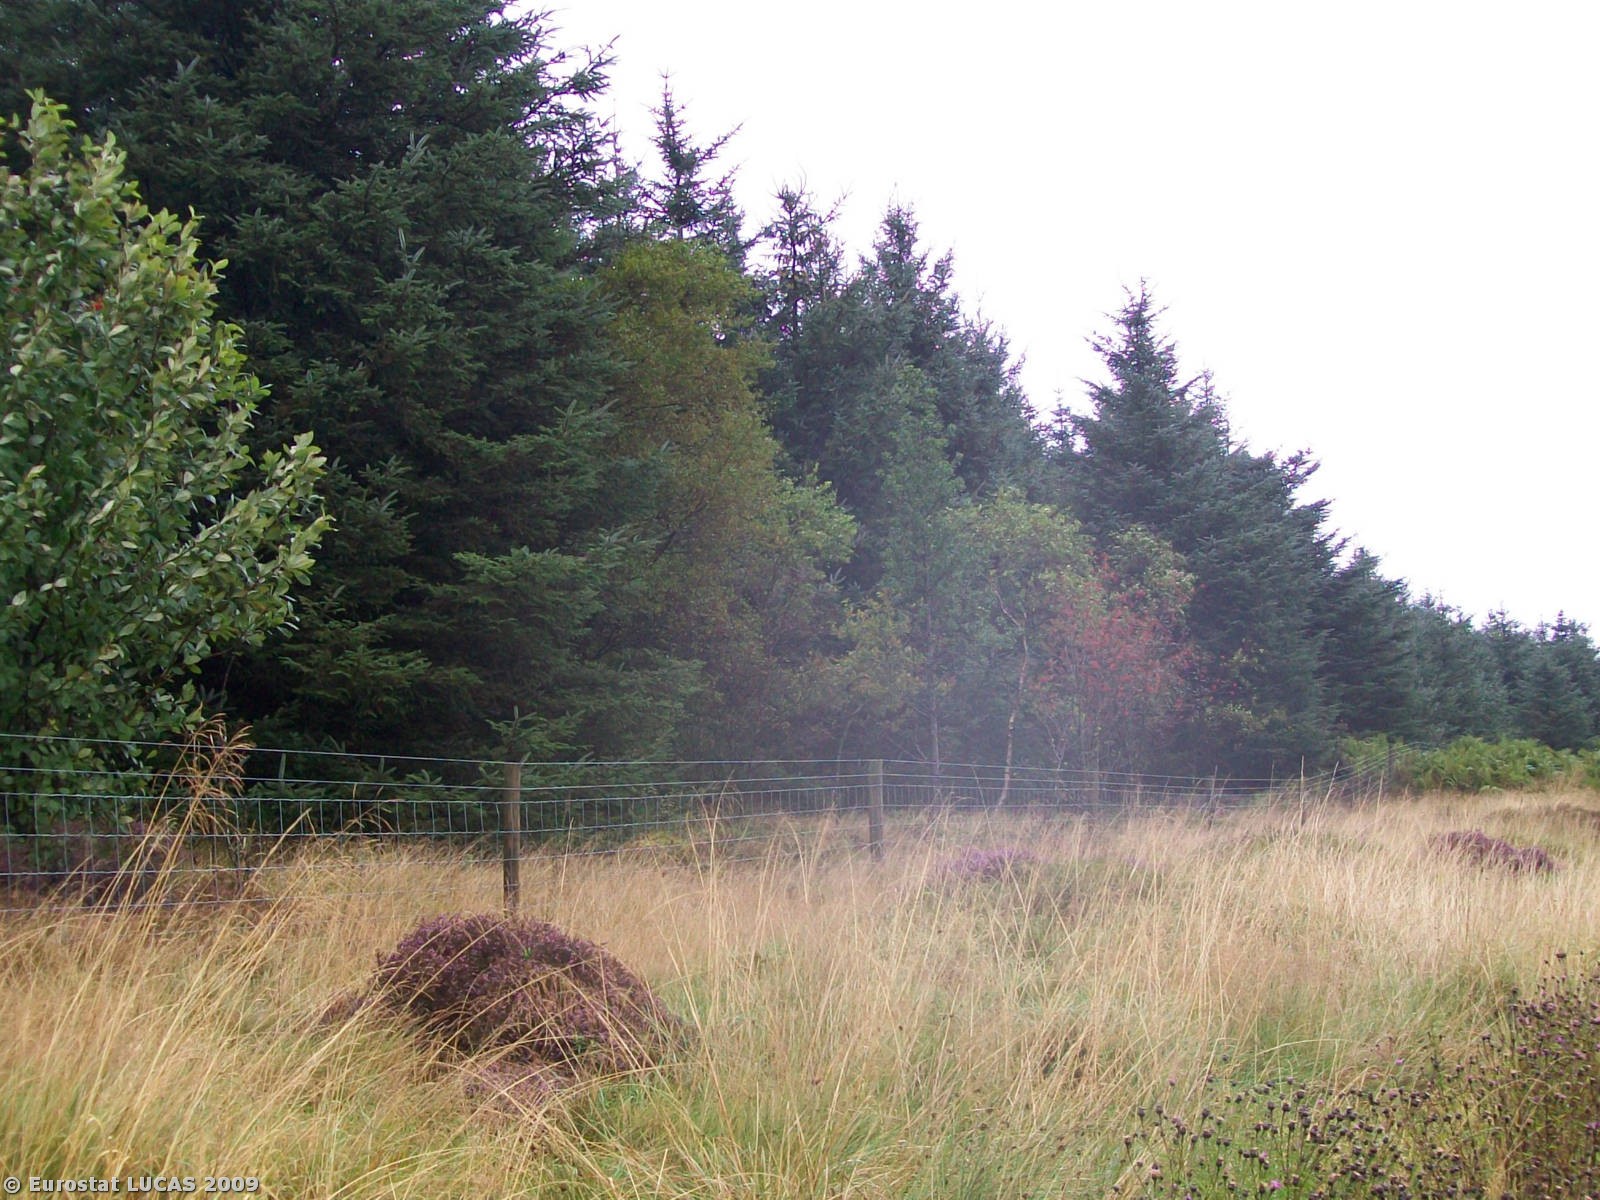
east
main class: Woodland
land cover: Coniferous woodland
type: plantations and self-sown exotic forest
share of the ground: > 75 %
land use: Forestry
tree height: > 5 m
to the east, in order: Coniferous woodland
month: August
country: GB
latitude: 54.3382
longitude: -3.1648
